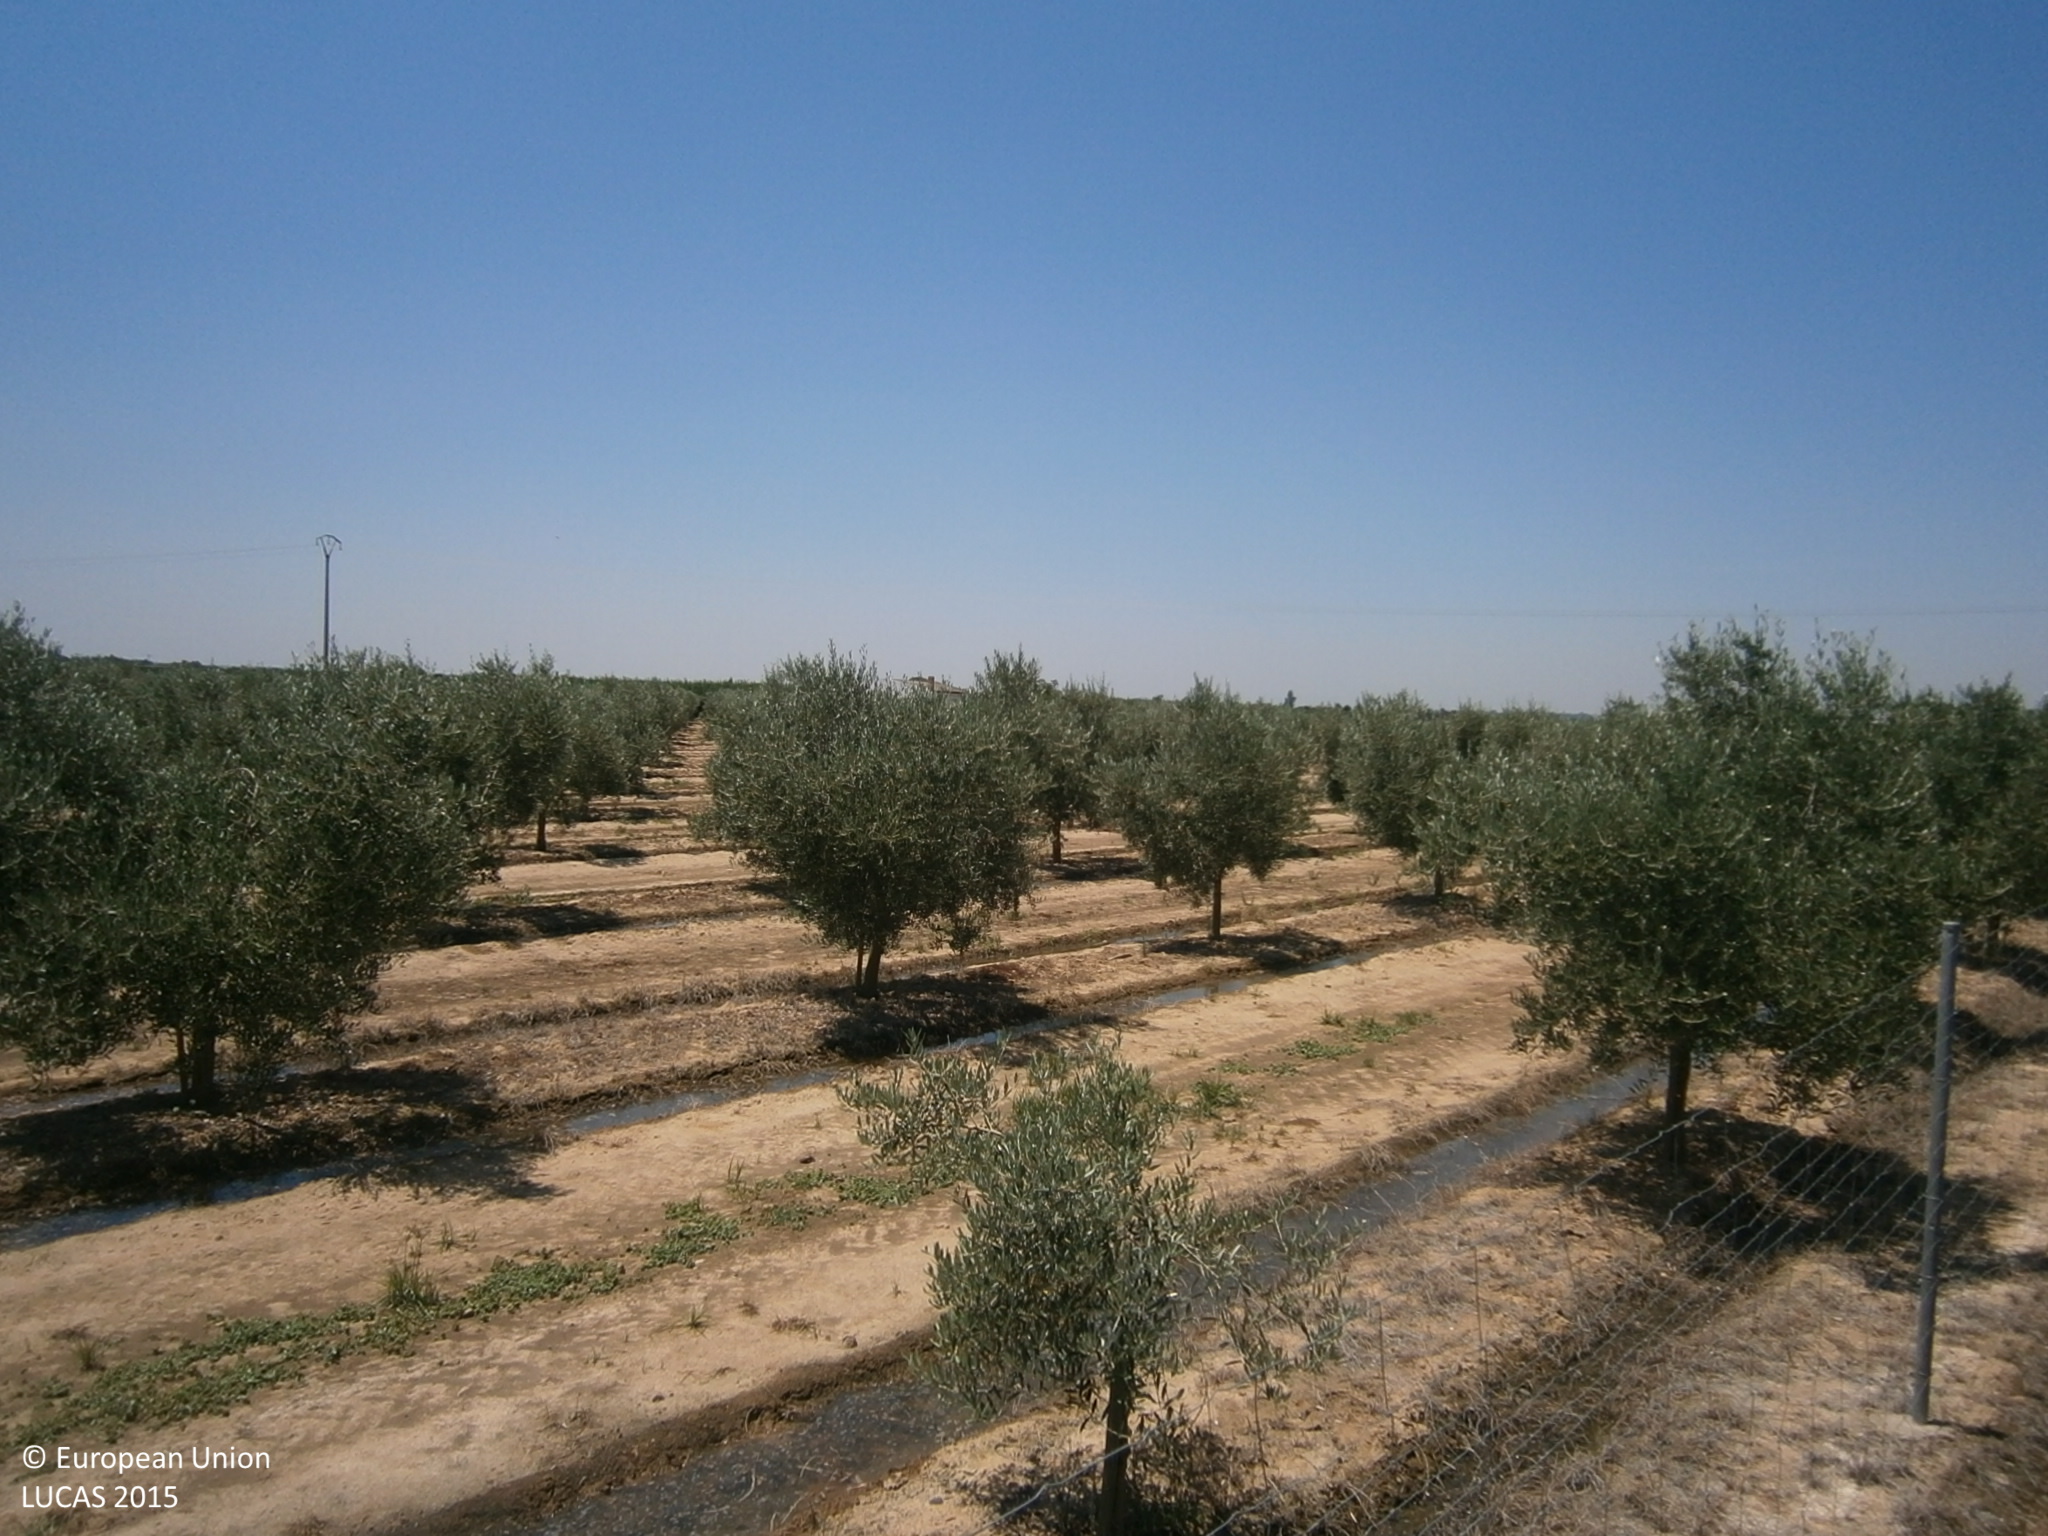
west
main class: Cropland
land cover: Maize
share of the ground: > 75 %
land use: Agriculture (excluding fallow land and kitchen gardens)
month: June
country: ES
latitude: 38.8802
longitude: -6.6980
